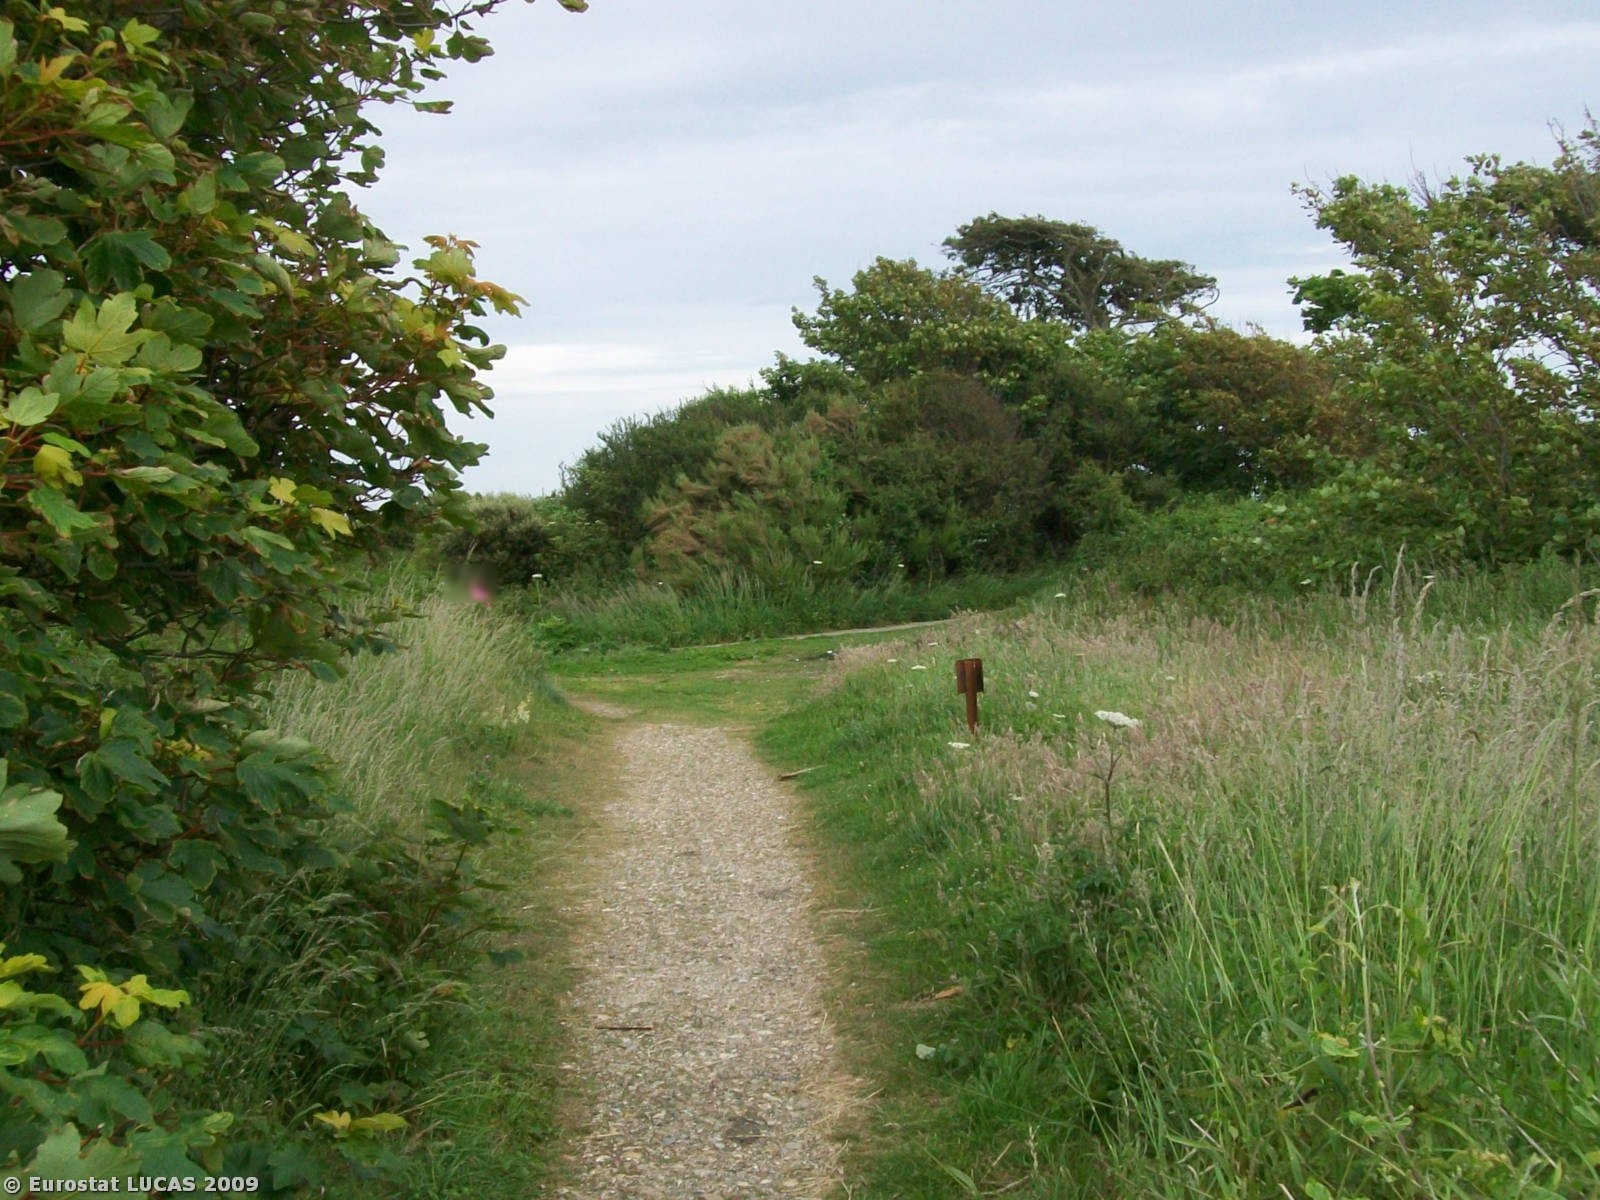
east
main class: Cropland
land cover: Common wheat
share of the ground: > 75 %
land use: Agriculture (excluding fallow land and kitchen gardens)
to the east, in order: Common wheat; Shrubland without tree cover; Broadleaved woodland
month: June
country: GB
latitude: 50.7969
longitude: -0.5806
